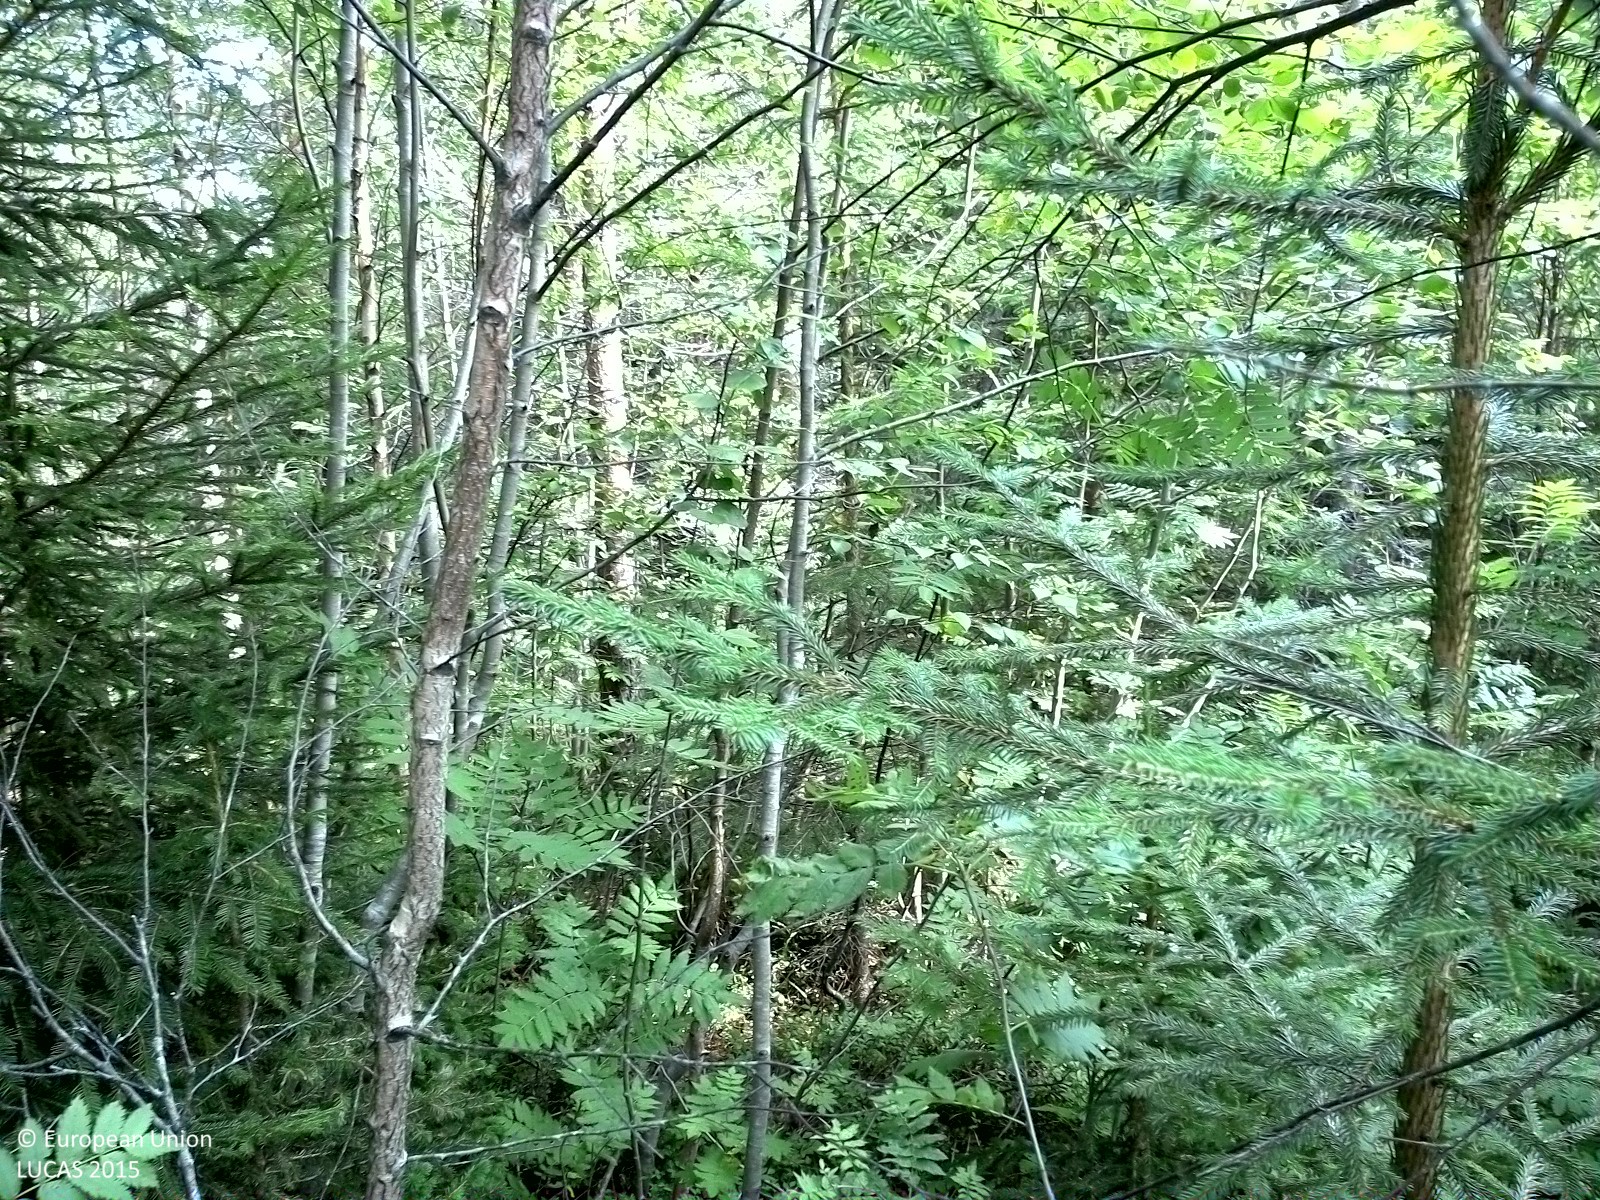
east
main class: Woodland
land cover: Other mixed woodland
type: boreal forest
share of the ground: > 75 %
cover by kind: broadleaved forest trees 50 %, coniferous forest trees 30 %, herbaceous plants 15 %, shrubs 5 %
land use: Forestry
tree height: > 5 m
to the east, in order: Other mixed woodland; Broadleaved woodland; Pine dominated coniferous woodland; Other mixed woodland; Ditches and canals; Tracks; Ditches and canals; Other mixed woodland
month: August
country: SE
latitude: 62.3663
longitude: 17.2278
